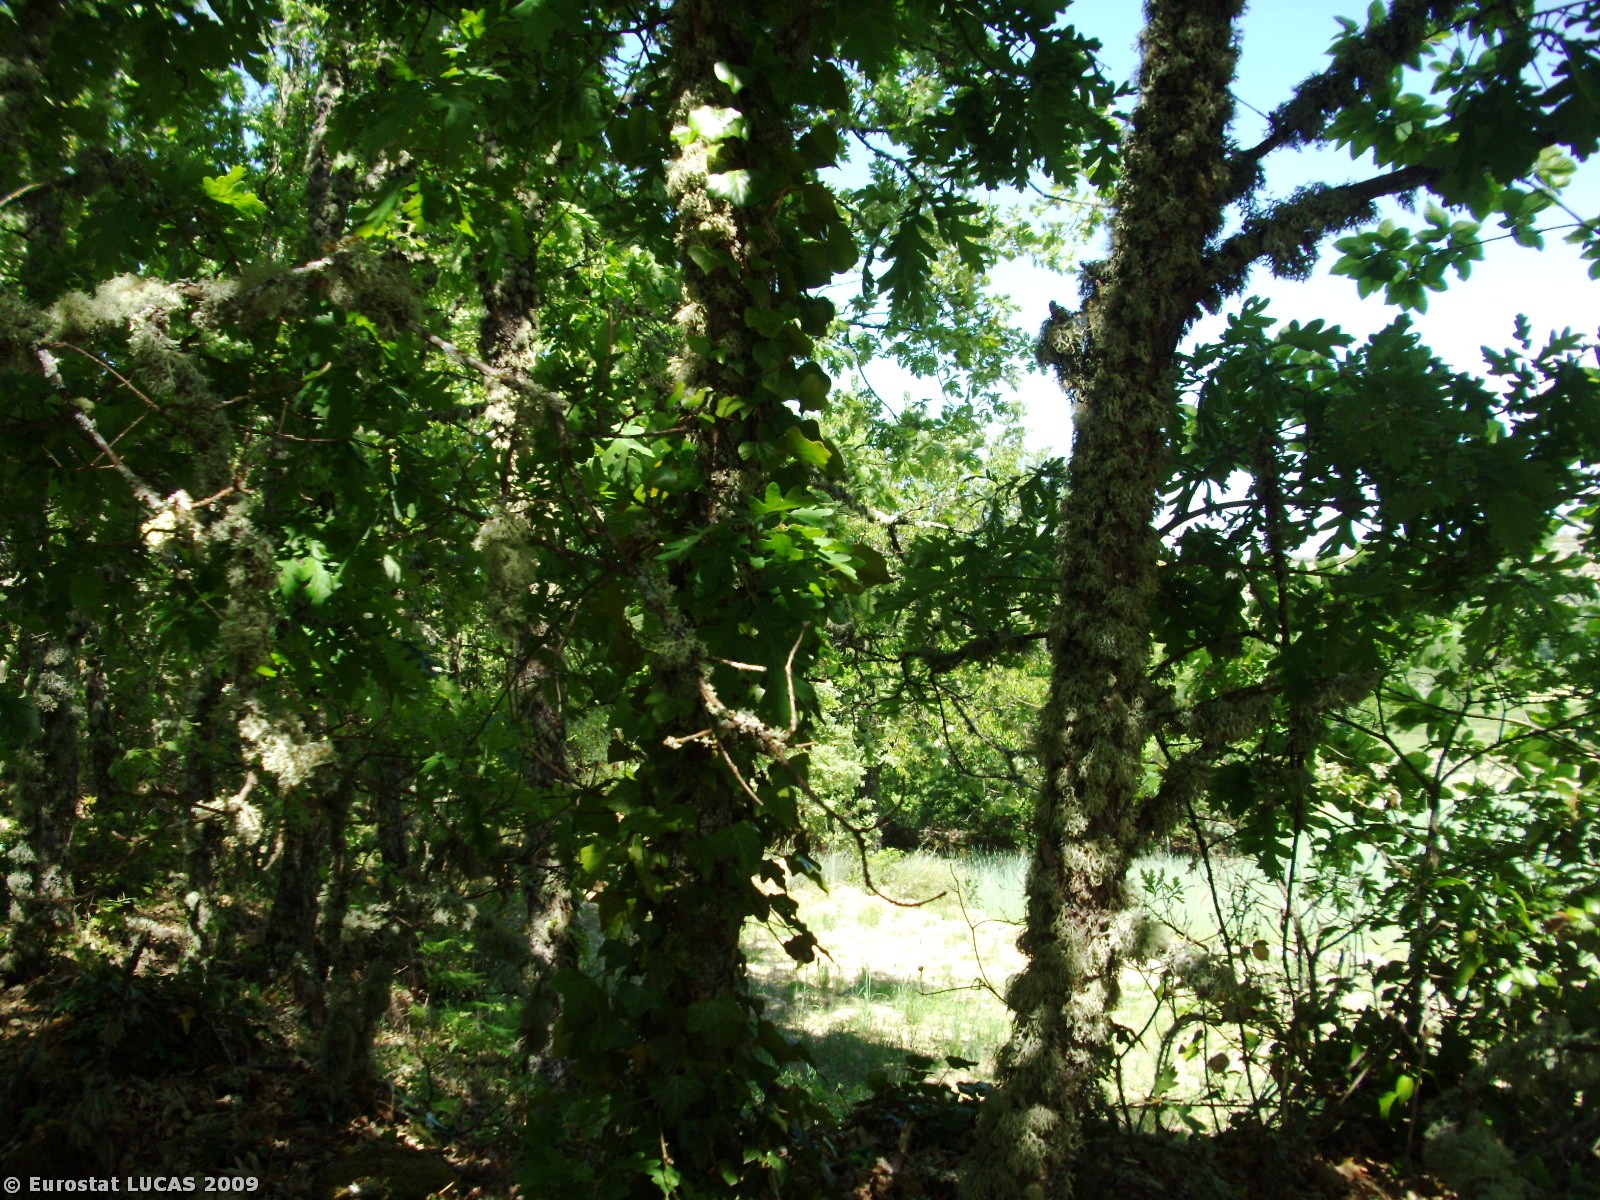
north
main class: Woodland
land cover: Broadleaved woodland
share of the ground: > 75 %
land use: Forestry
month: May
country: PT
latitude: 40.7825
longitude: -7.3046
